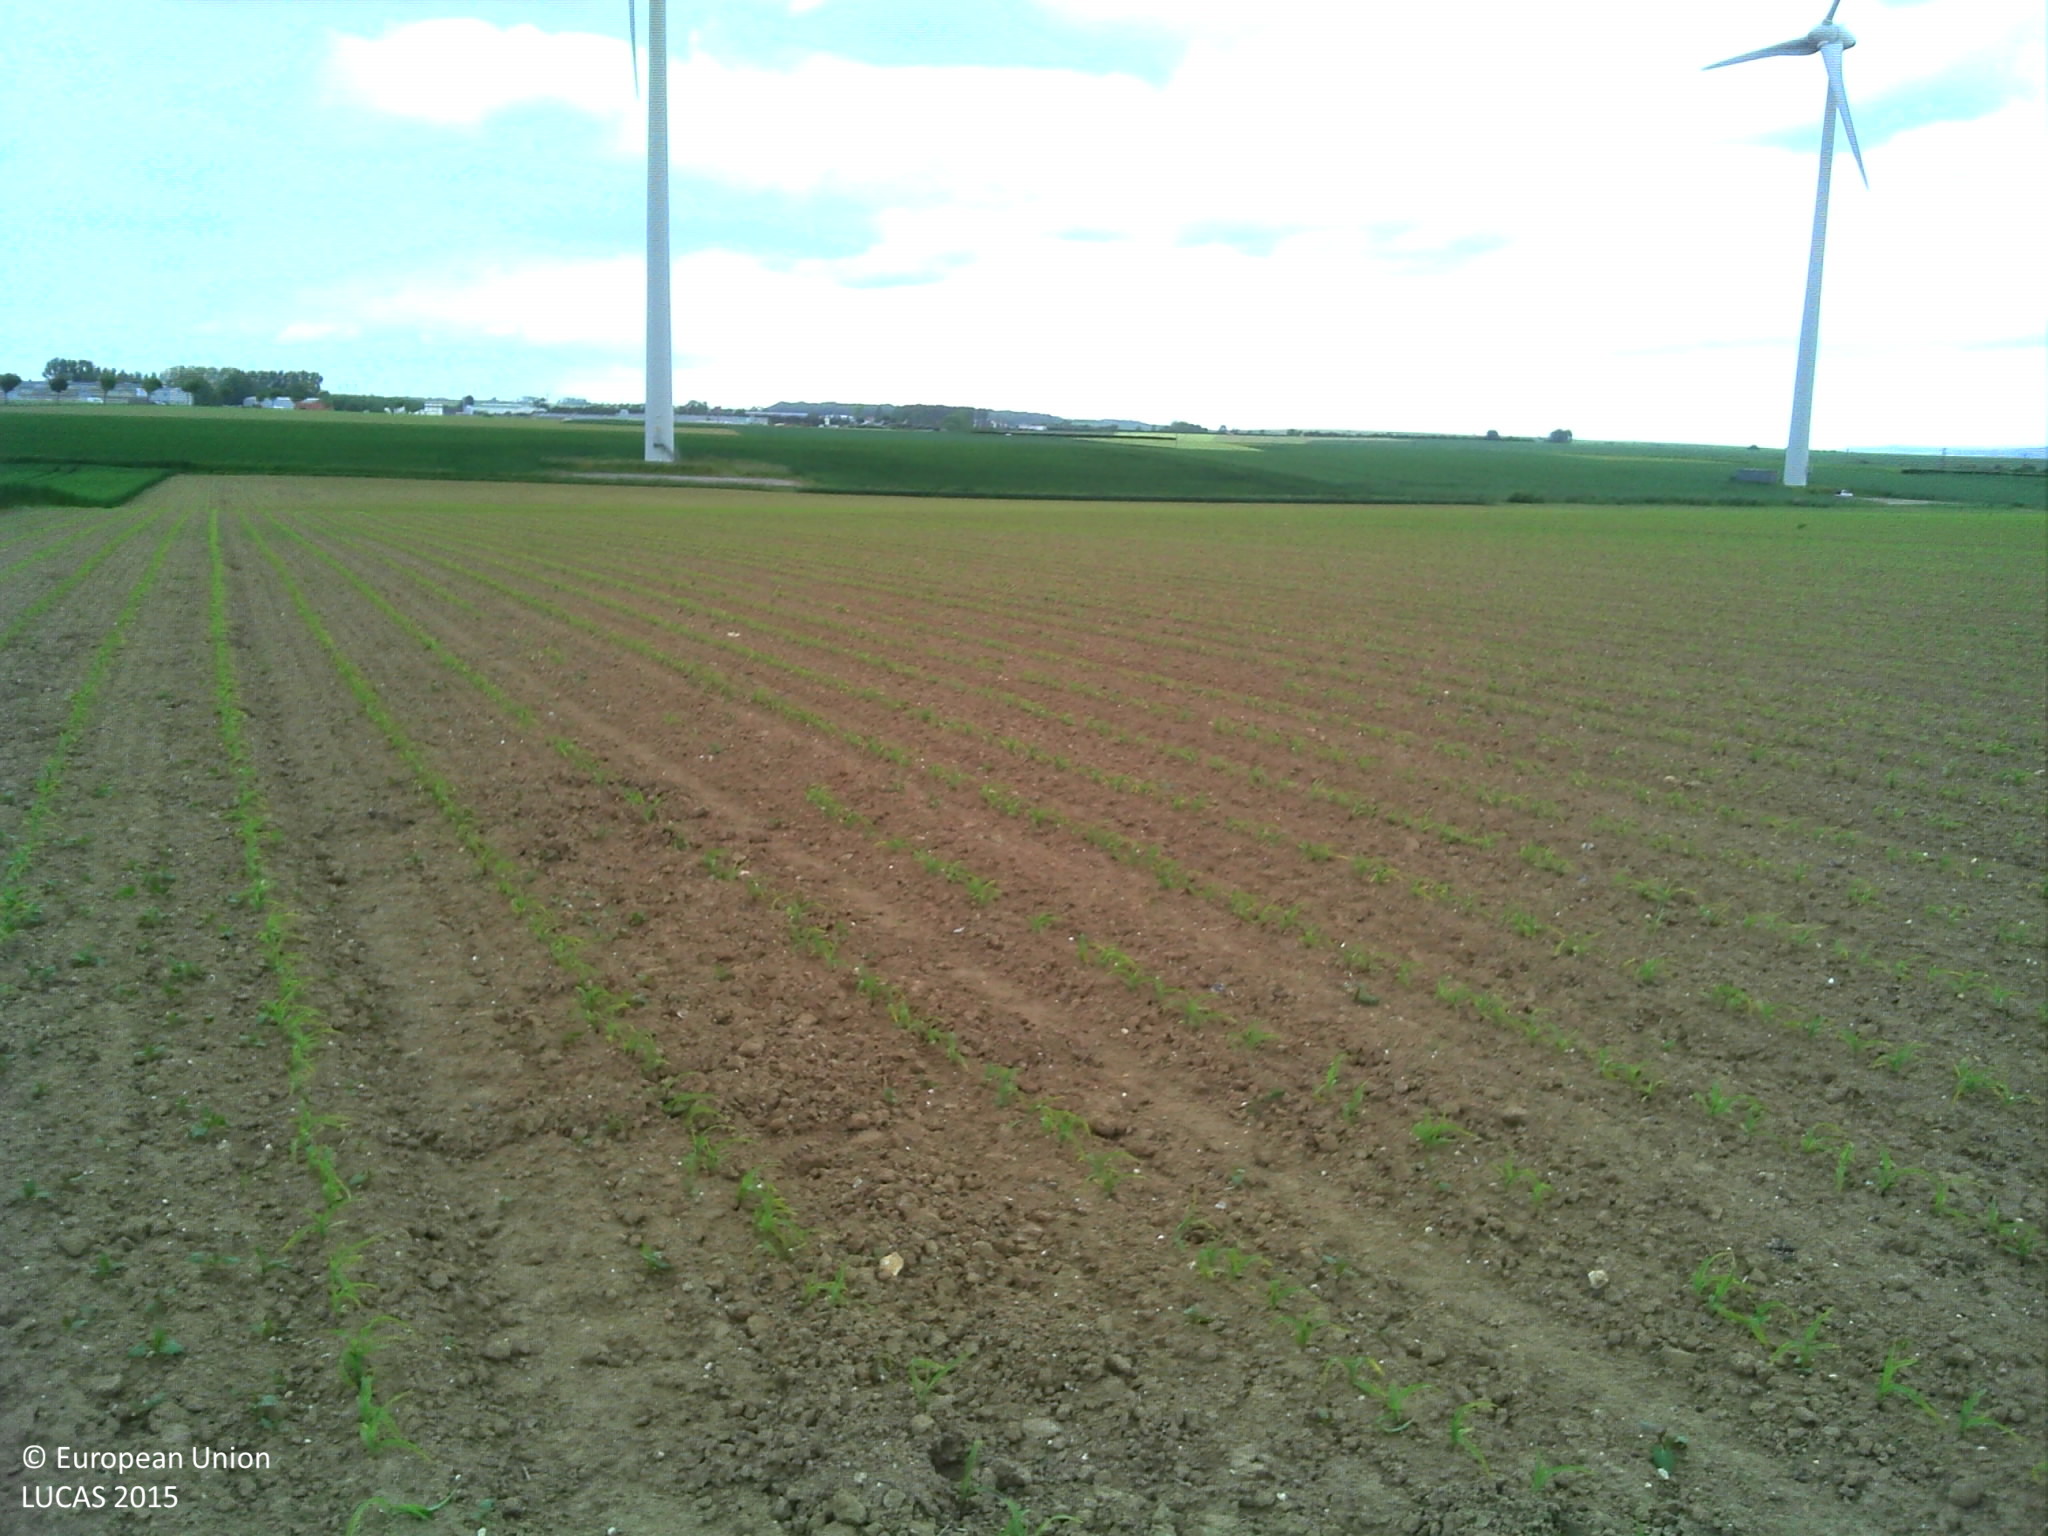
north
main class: Cropland
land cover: Maize
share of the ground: < 10 %
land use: Agriculture (excluding fallow land and kitchen gardens)
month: May
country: FR
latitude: 50.4904
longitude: 2.1340
